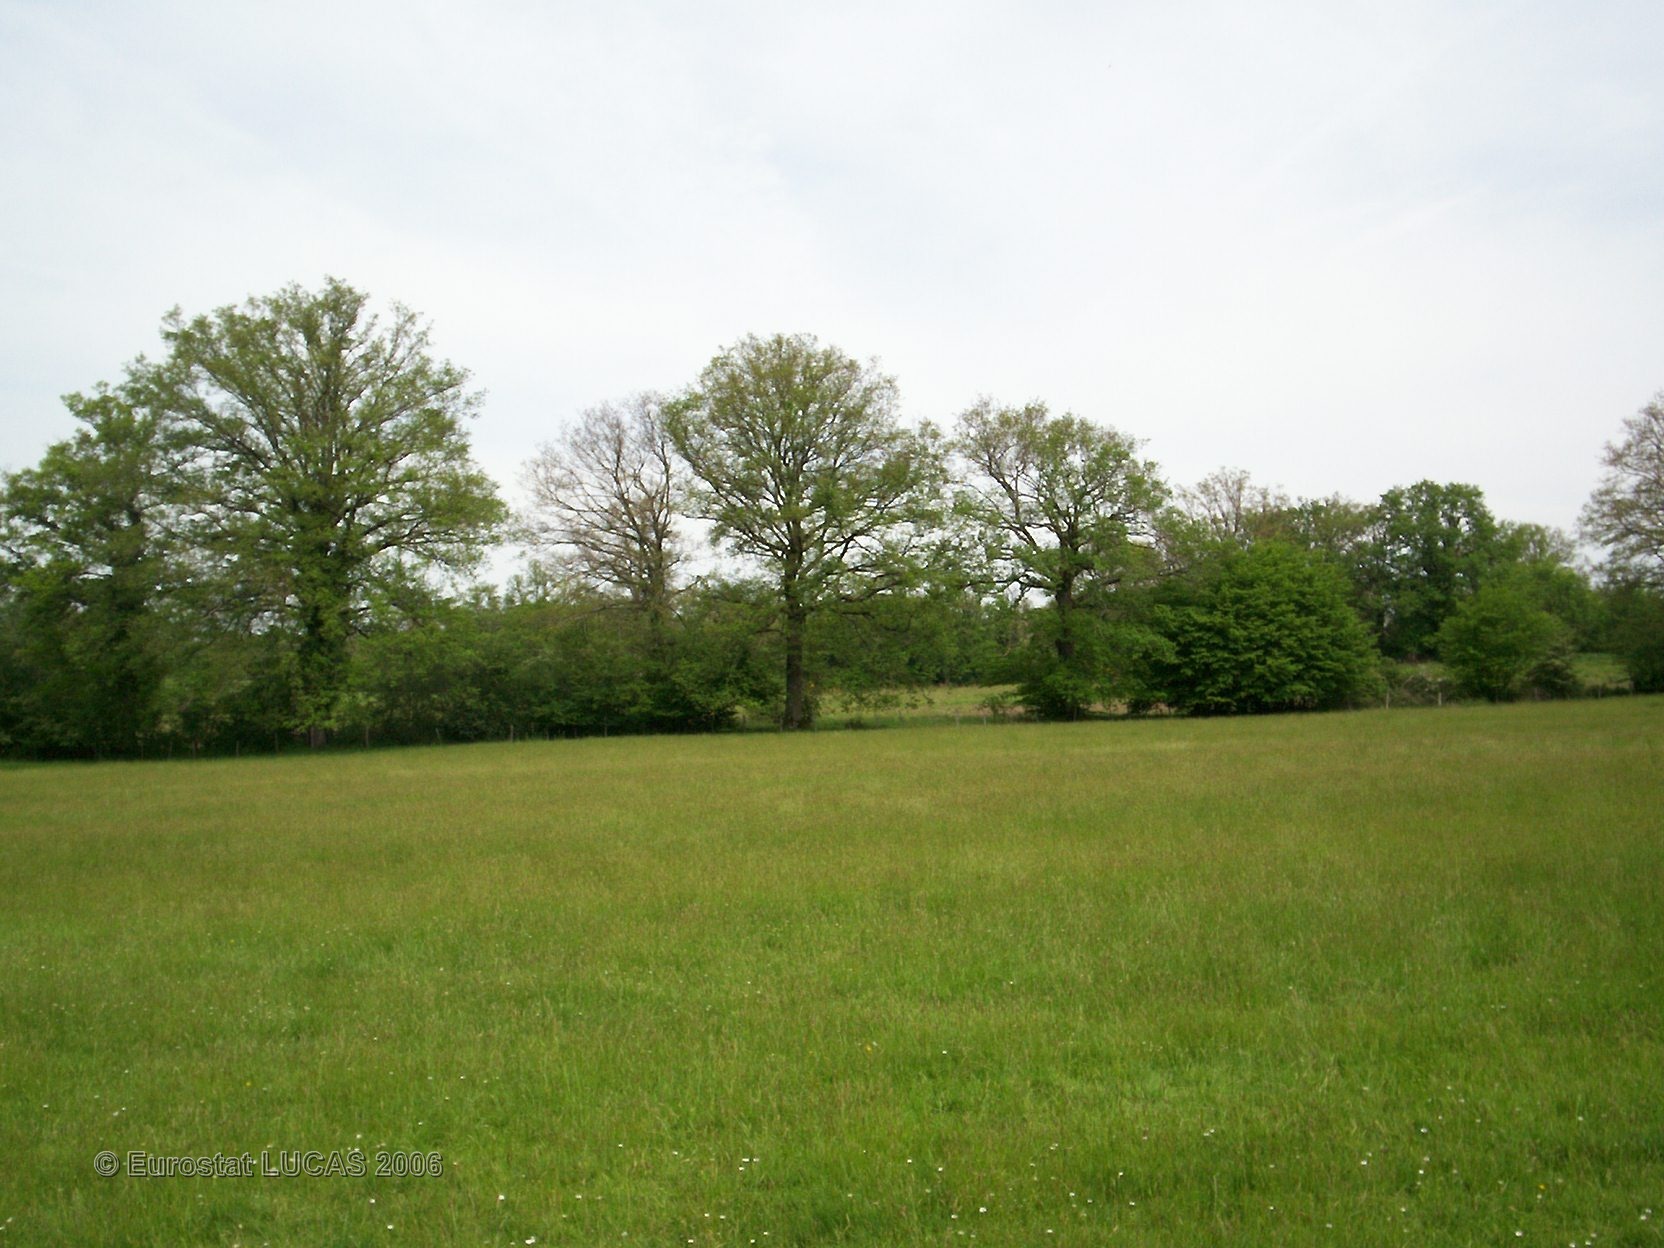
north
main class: Grassland
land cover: Grassland without tree/shrub cover
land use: Agriculture (excluding fallow land and kitchen gardens)
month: May
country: FR
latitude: 46.1622
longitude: 1.1176
